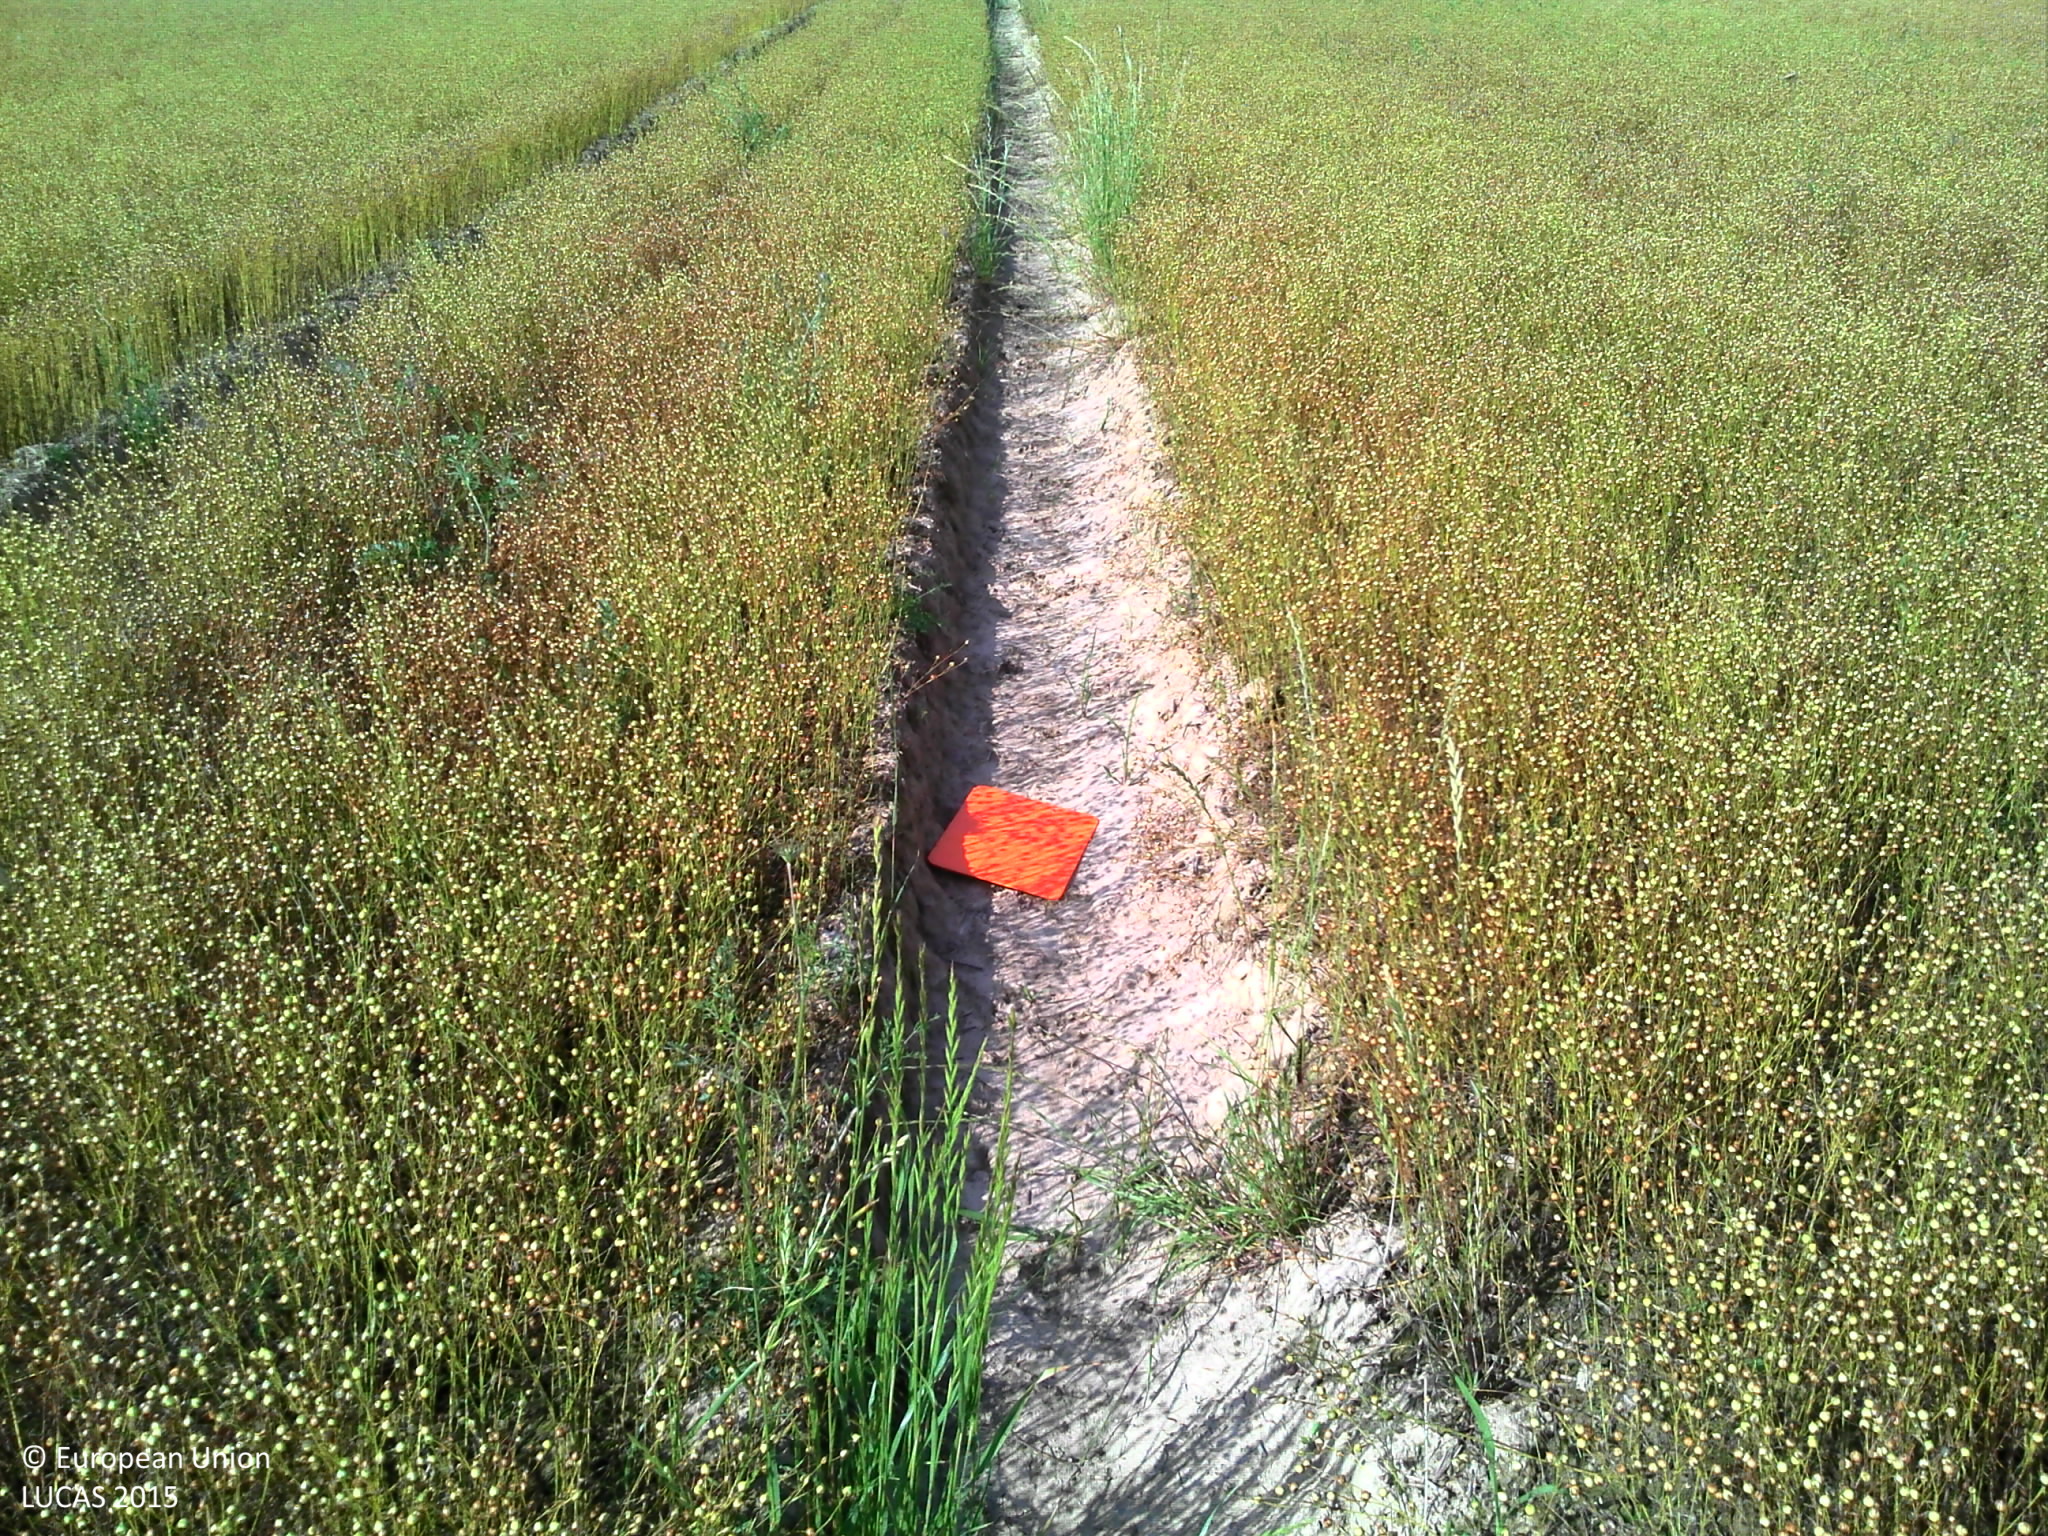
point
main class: Cropland
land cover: Other fibre and oleaginous crops
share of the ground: > 75 %
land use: Agriculture (excluding fallow land and kitchen gardens)
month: June
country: FR
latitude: 46.9055
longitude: 0.4892
